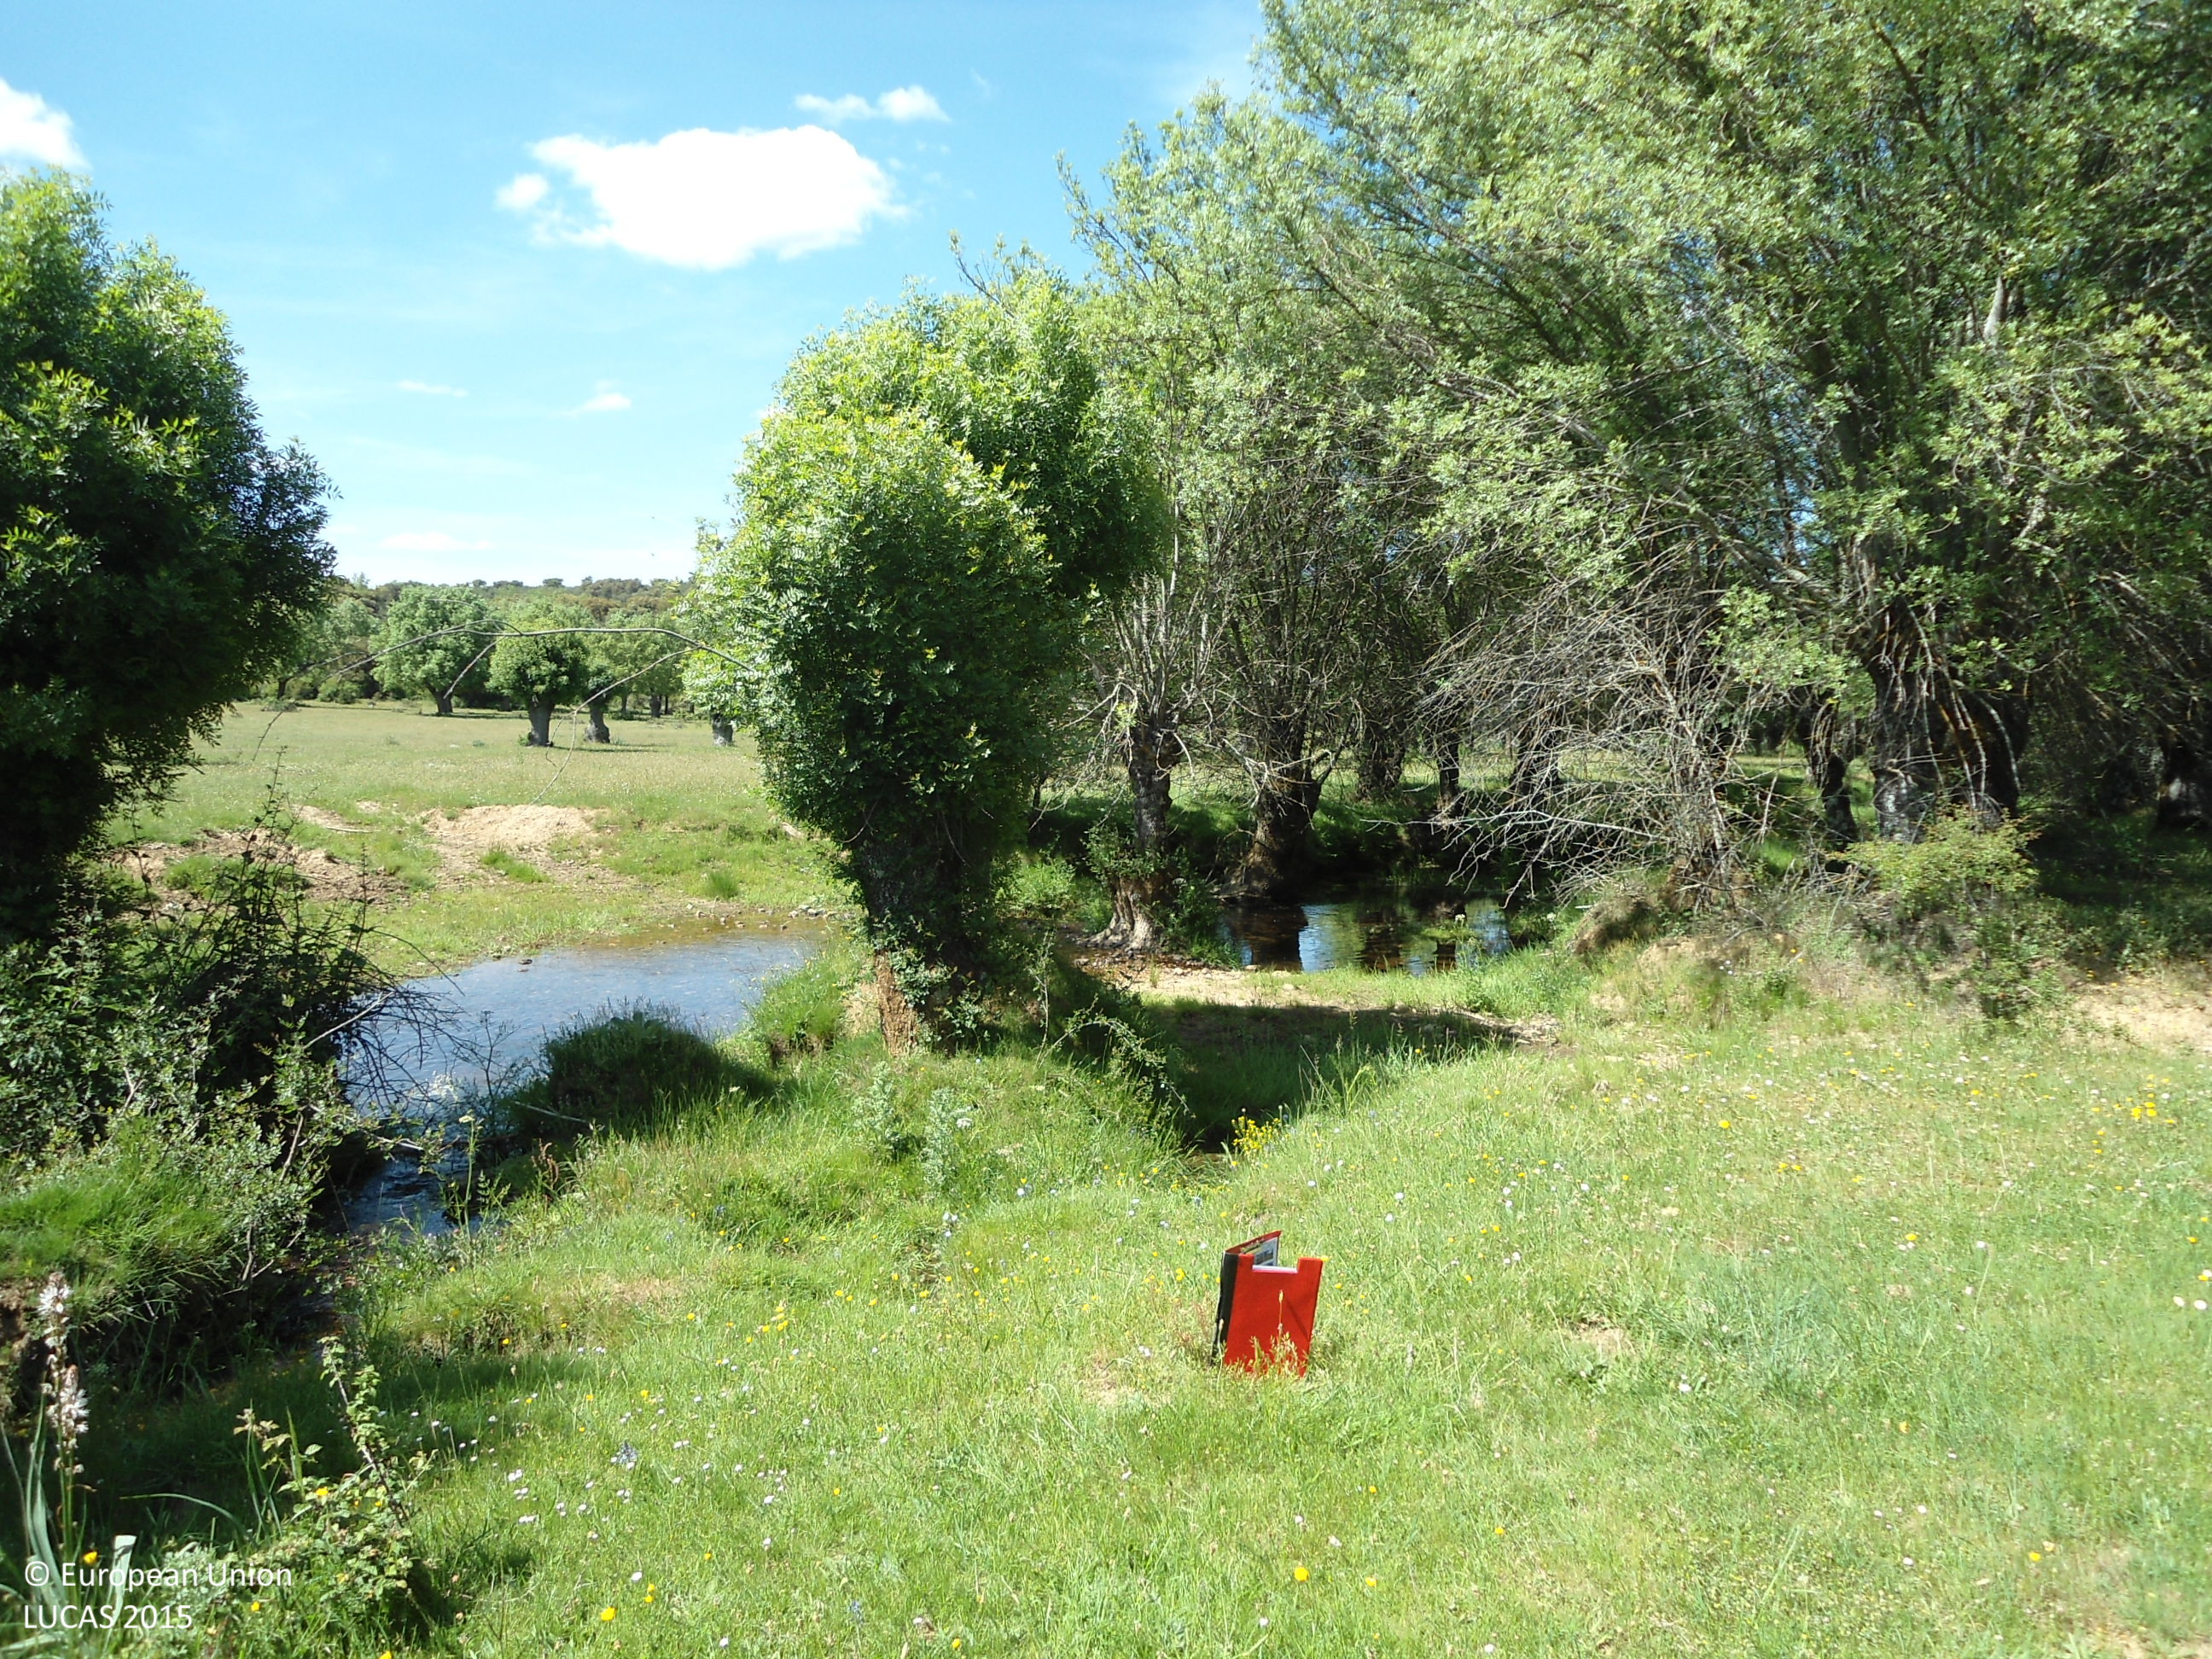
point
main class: Woodland
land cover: Broadleaved woodland
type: floodplain forest
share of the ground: > 75 %
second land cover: Grassland without tree/shrub cover
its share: > 75 %
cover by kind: broadleaved forest trees 75 %, herbaceous plants 25 %
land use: Forestry
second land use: Agriculture (excluding fallow land and kitchen gardens)
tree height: > 5 m
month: May
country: ES
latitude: 41.9233
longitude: -6.0025
